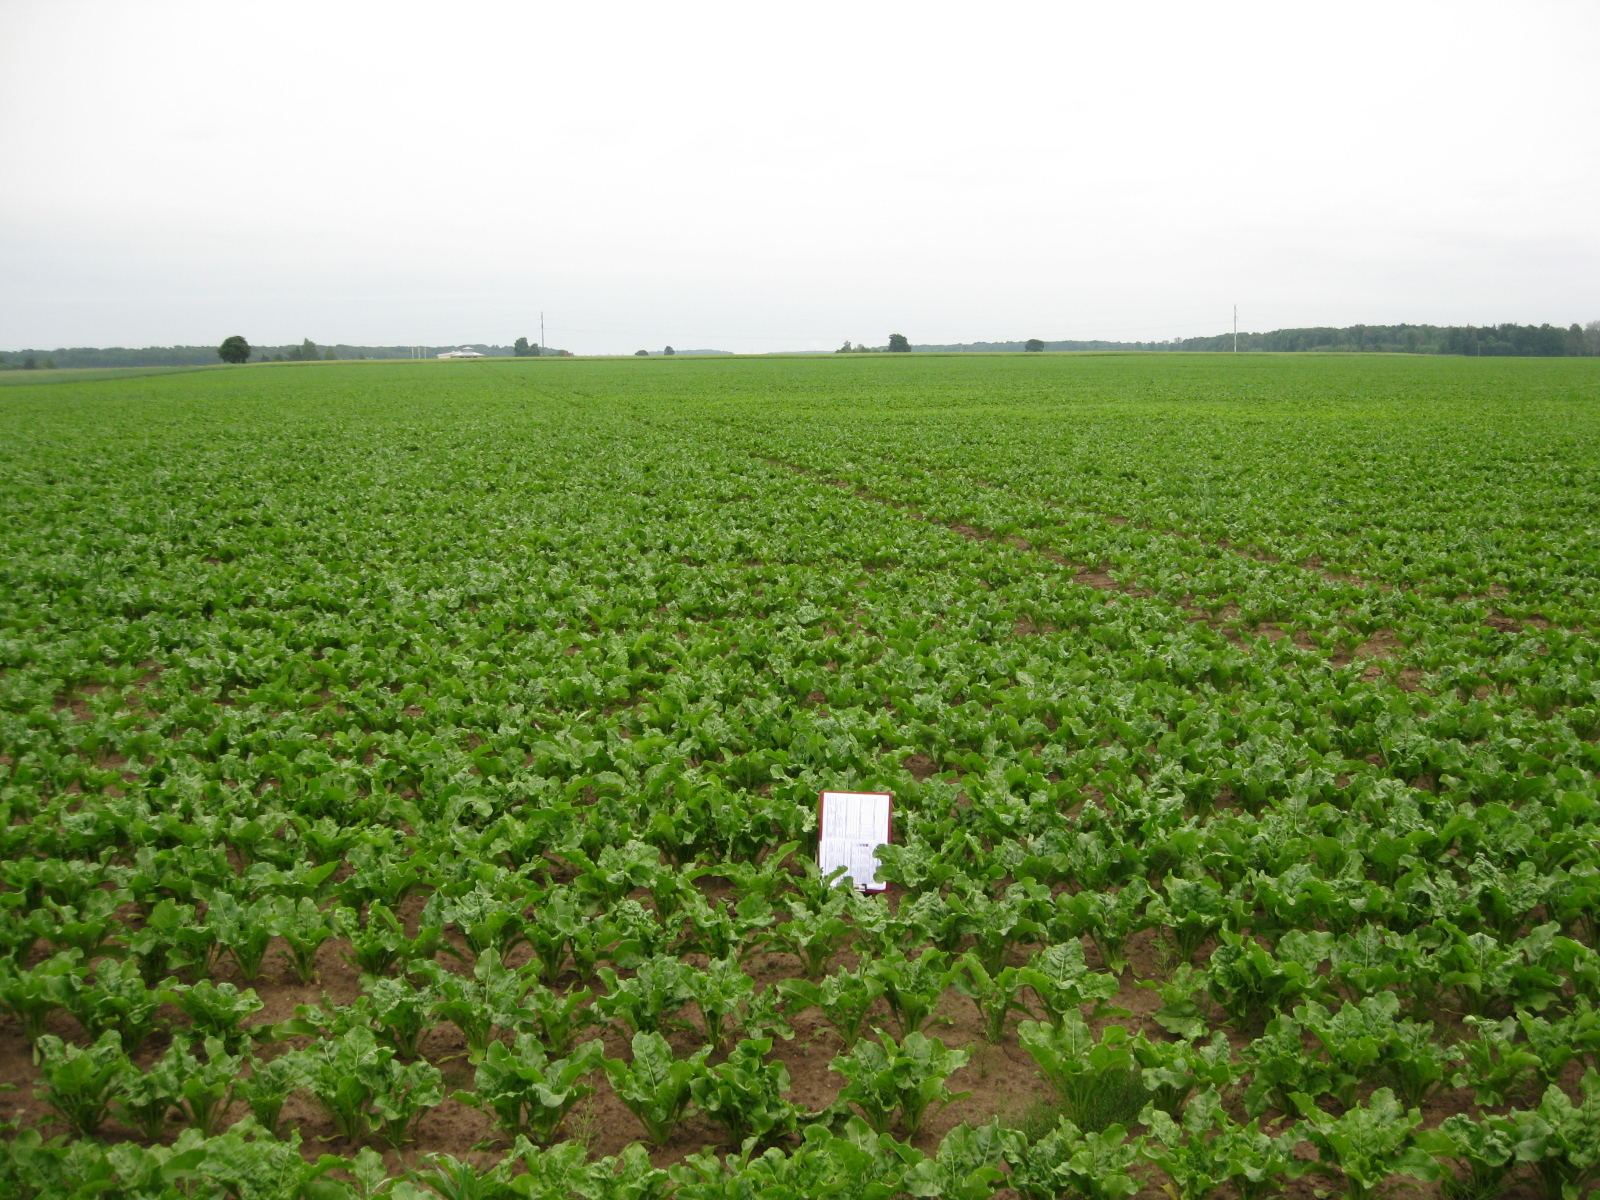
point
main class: Cropland
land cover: Sugar beet
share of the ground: 50 - 75 %
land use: Agriculture (excluding fallow land and kitchen gardens)
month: June
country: LT
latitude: 55.1612
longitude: 23.9809
